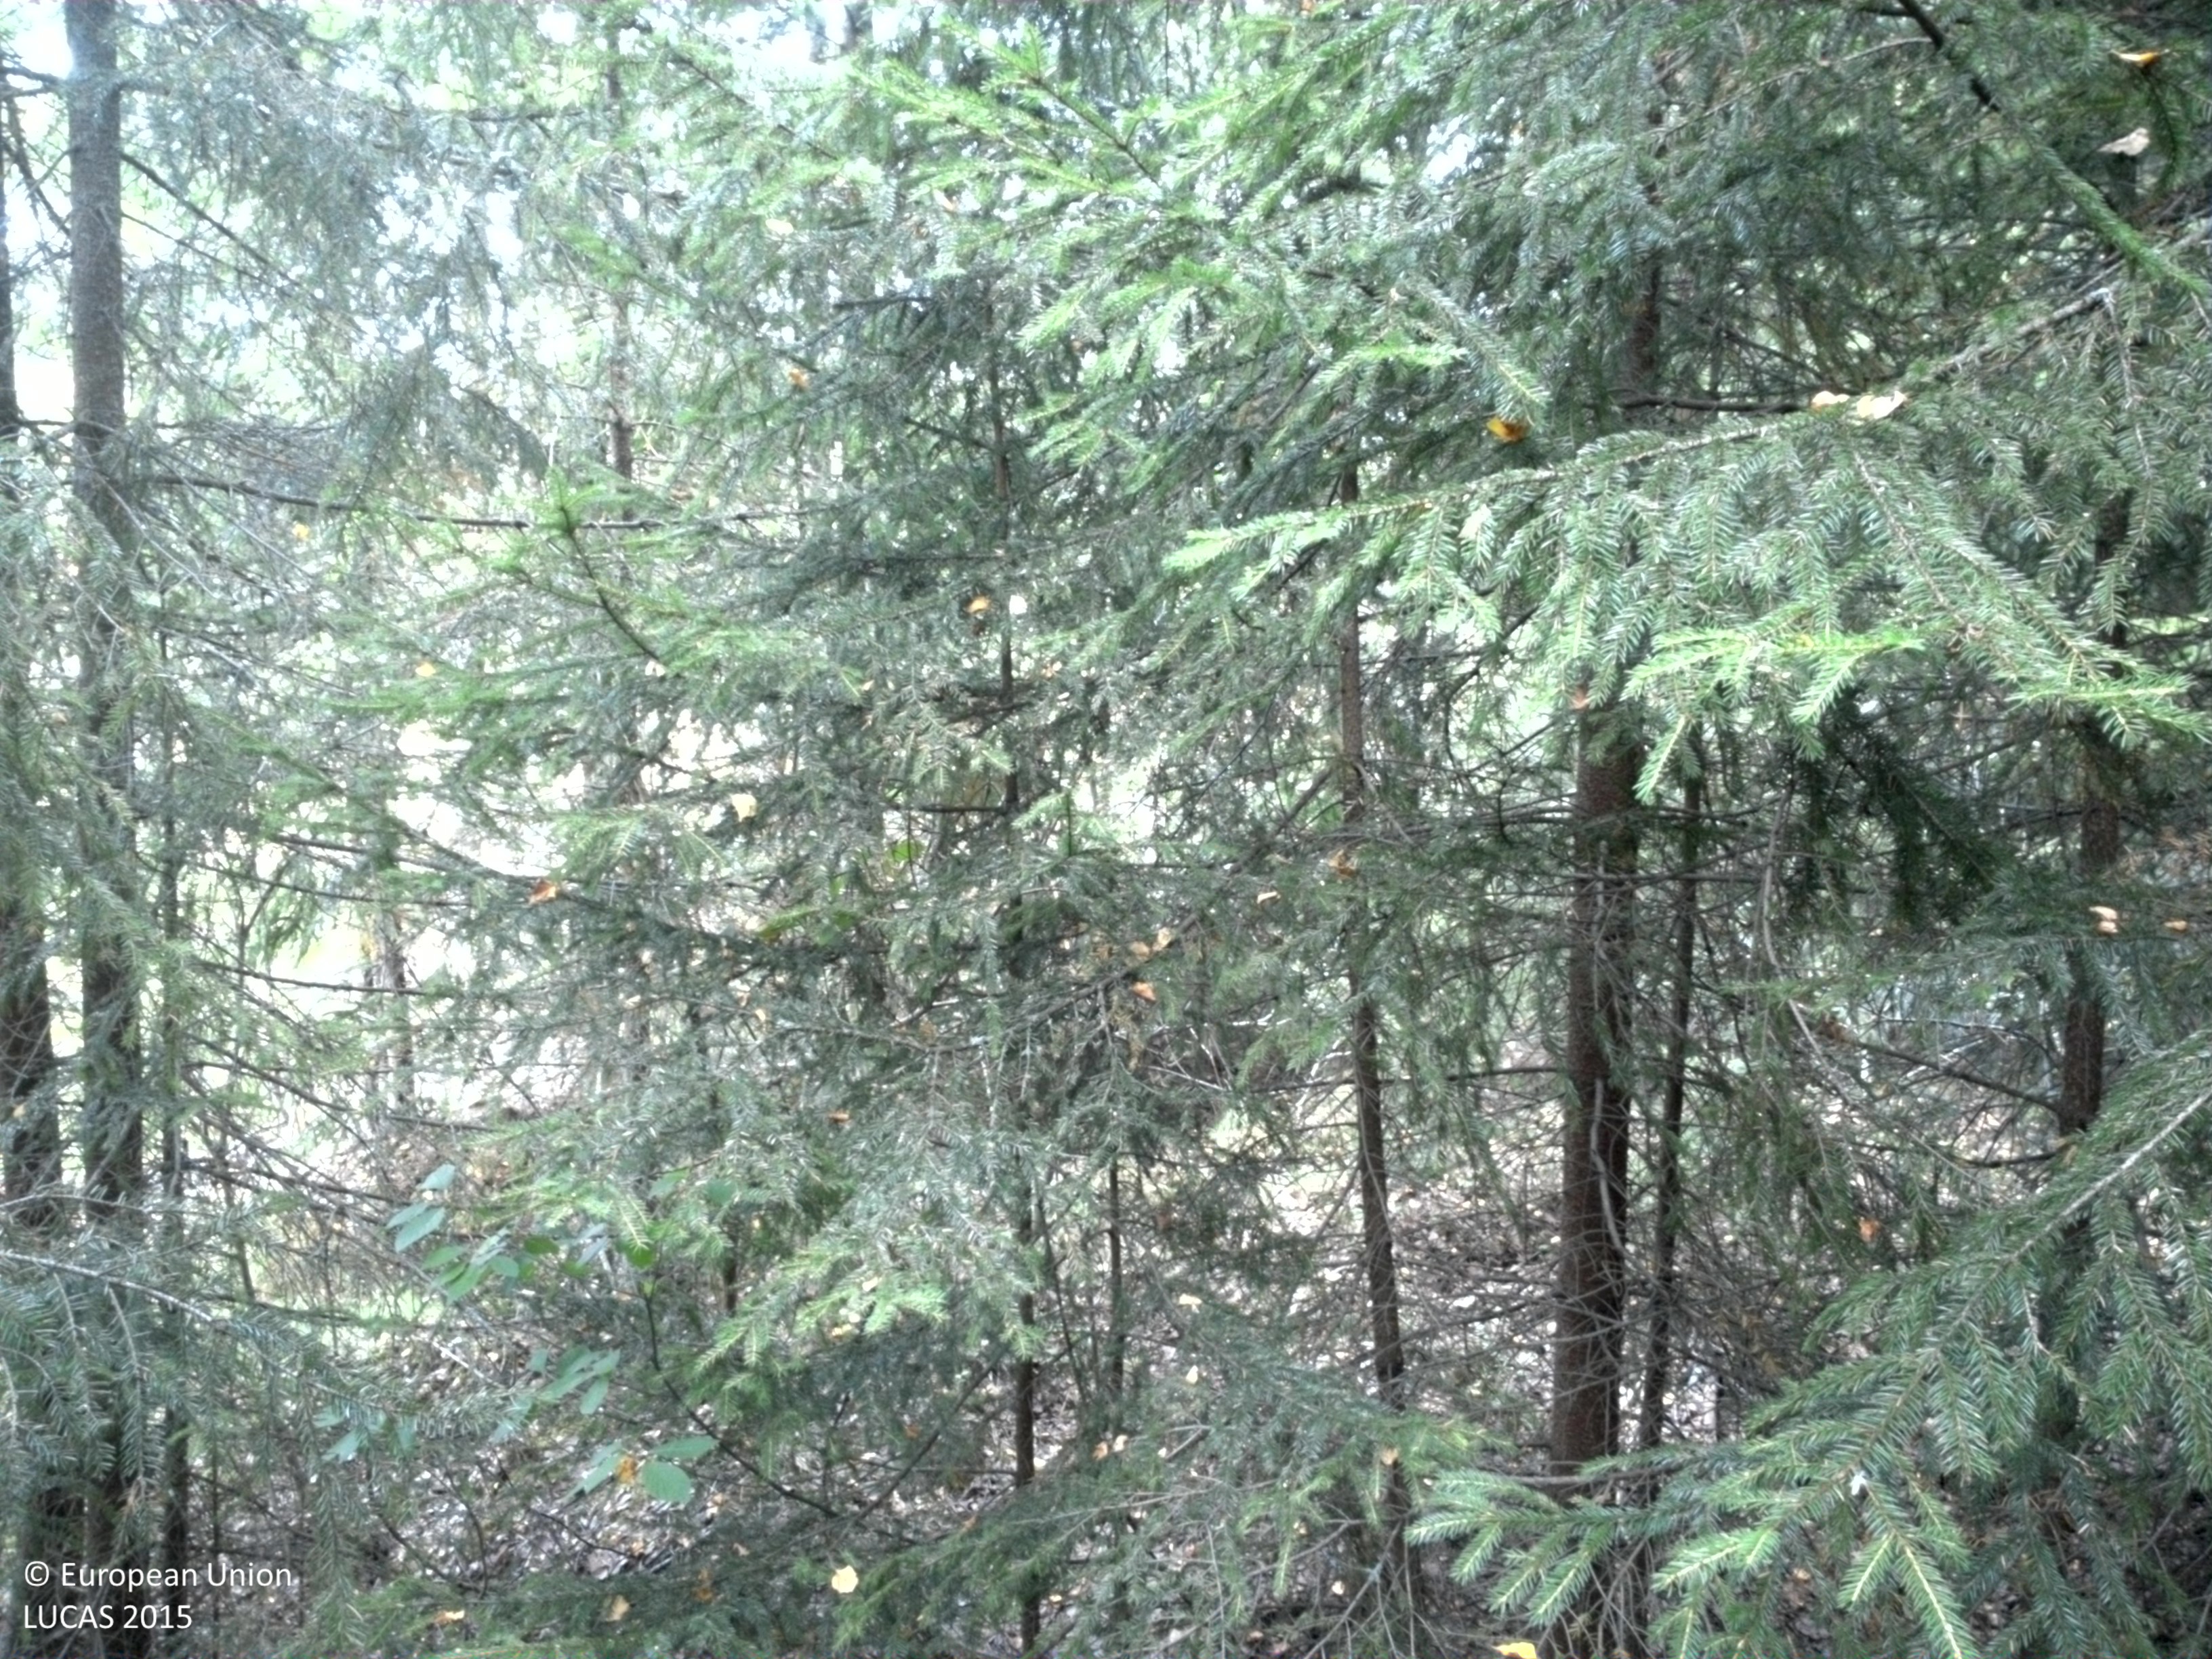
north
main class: Woodland
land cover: Spruce dominated mixed woodland
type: boreal forest
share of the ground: > 75 %
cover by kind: coniferous forest trees 55 %, broadleaved forest trees 25 %, lichens and mosses 5 %
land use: Forestry
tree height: > 5 m
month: August
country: SE
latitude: 59.8660
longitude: 15.7225
